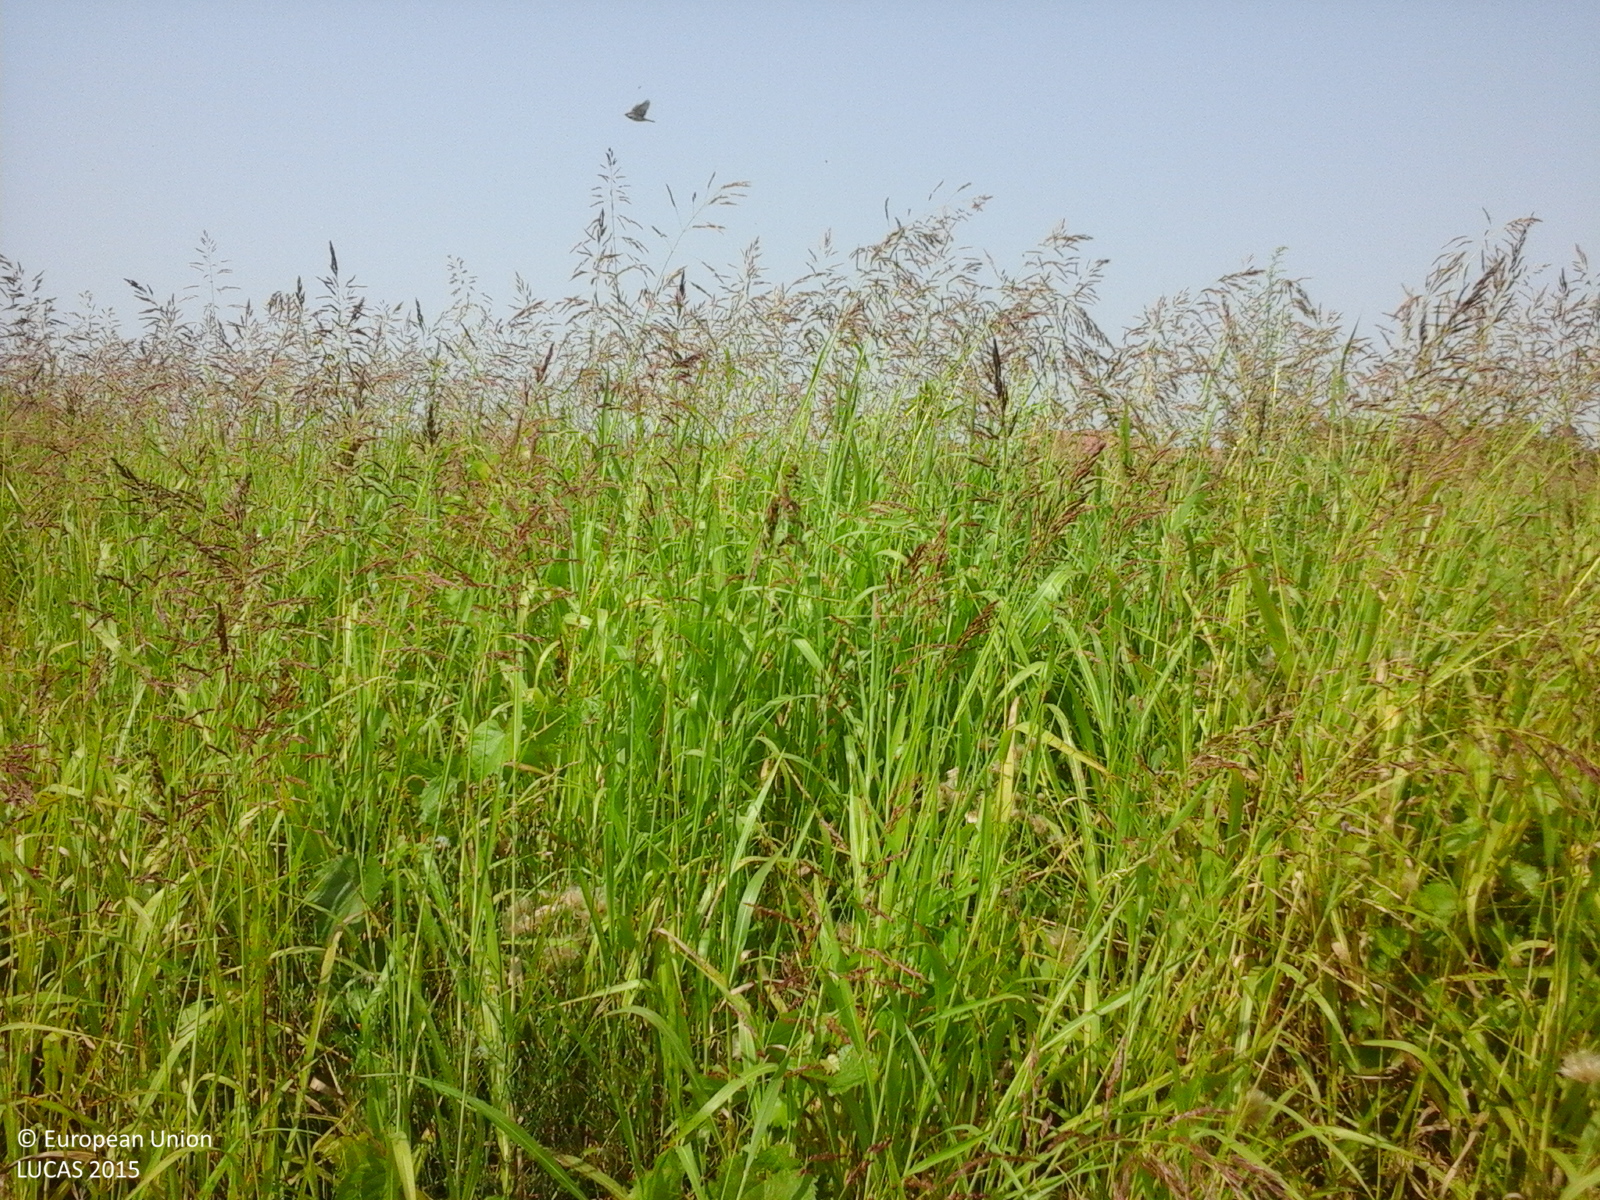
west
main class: Grassland
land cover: Spontaneously vegetated surfaces
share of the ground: > 75 %
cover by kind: herbaceous plants 100 %
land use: Semi-natural and natural areas not in use
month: July
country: RO
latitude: 44.7749
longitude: 26.6639
